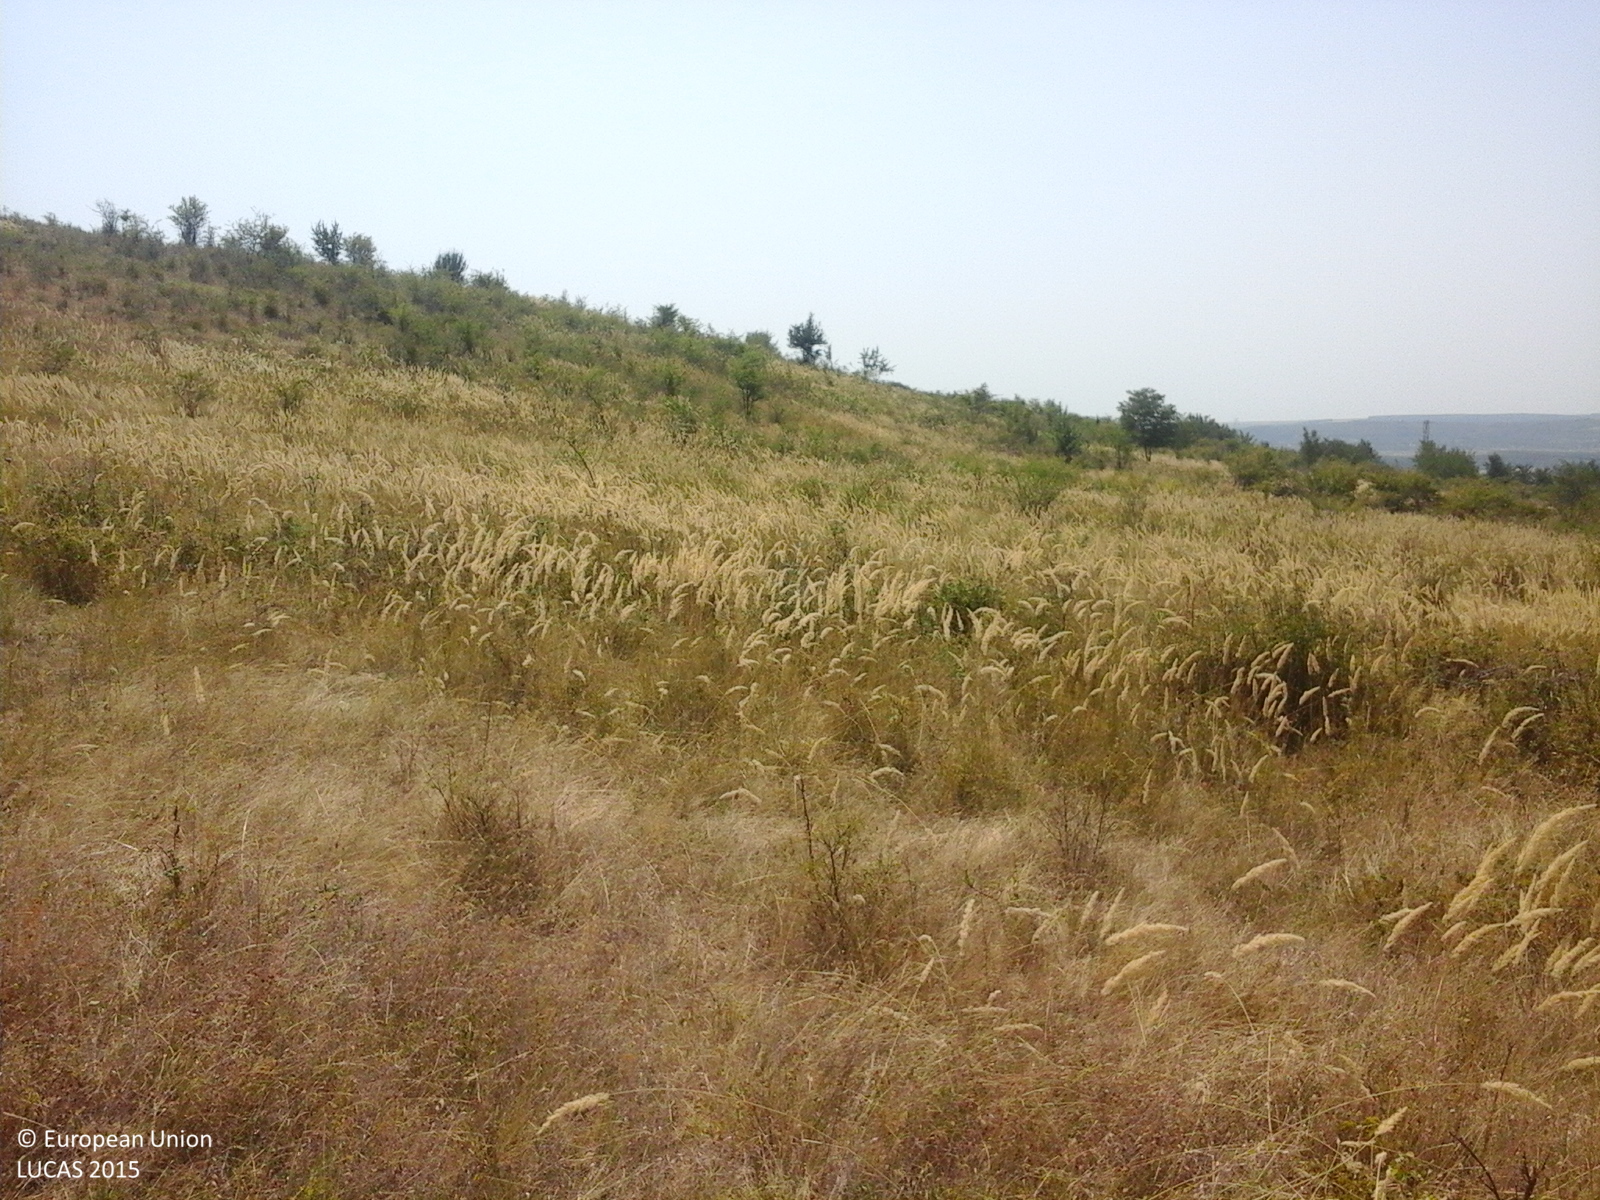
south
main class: Grassland
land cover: Grassland without tree/shrub cover
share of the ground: > 75 %
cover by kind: herbaceous plants 100 %
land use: Agriculture (excluding fallow land and kitchen gardens)
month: August
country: RO
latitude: 44.5273
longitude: 23.6070
